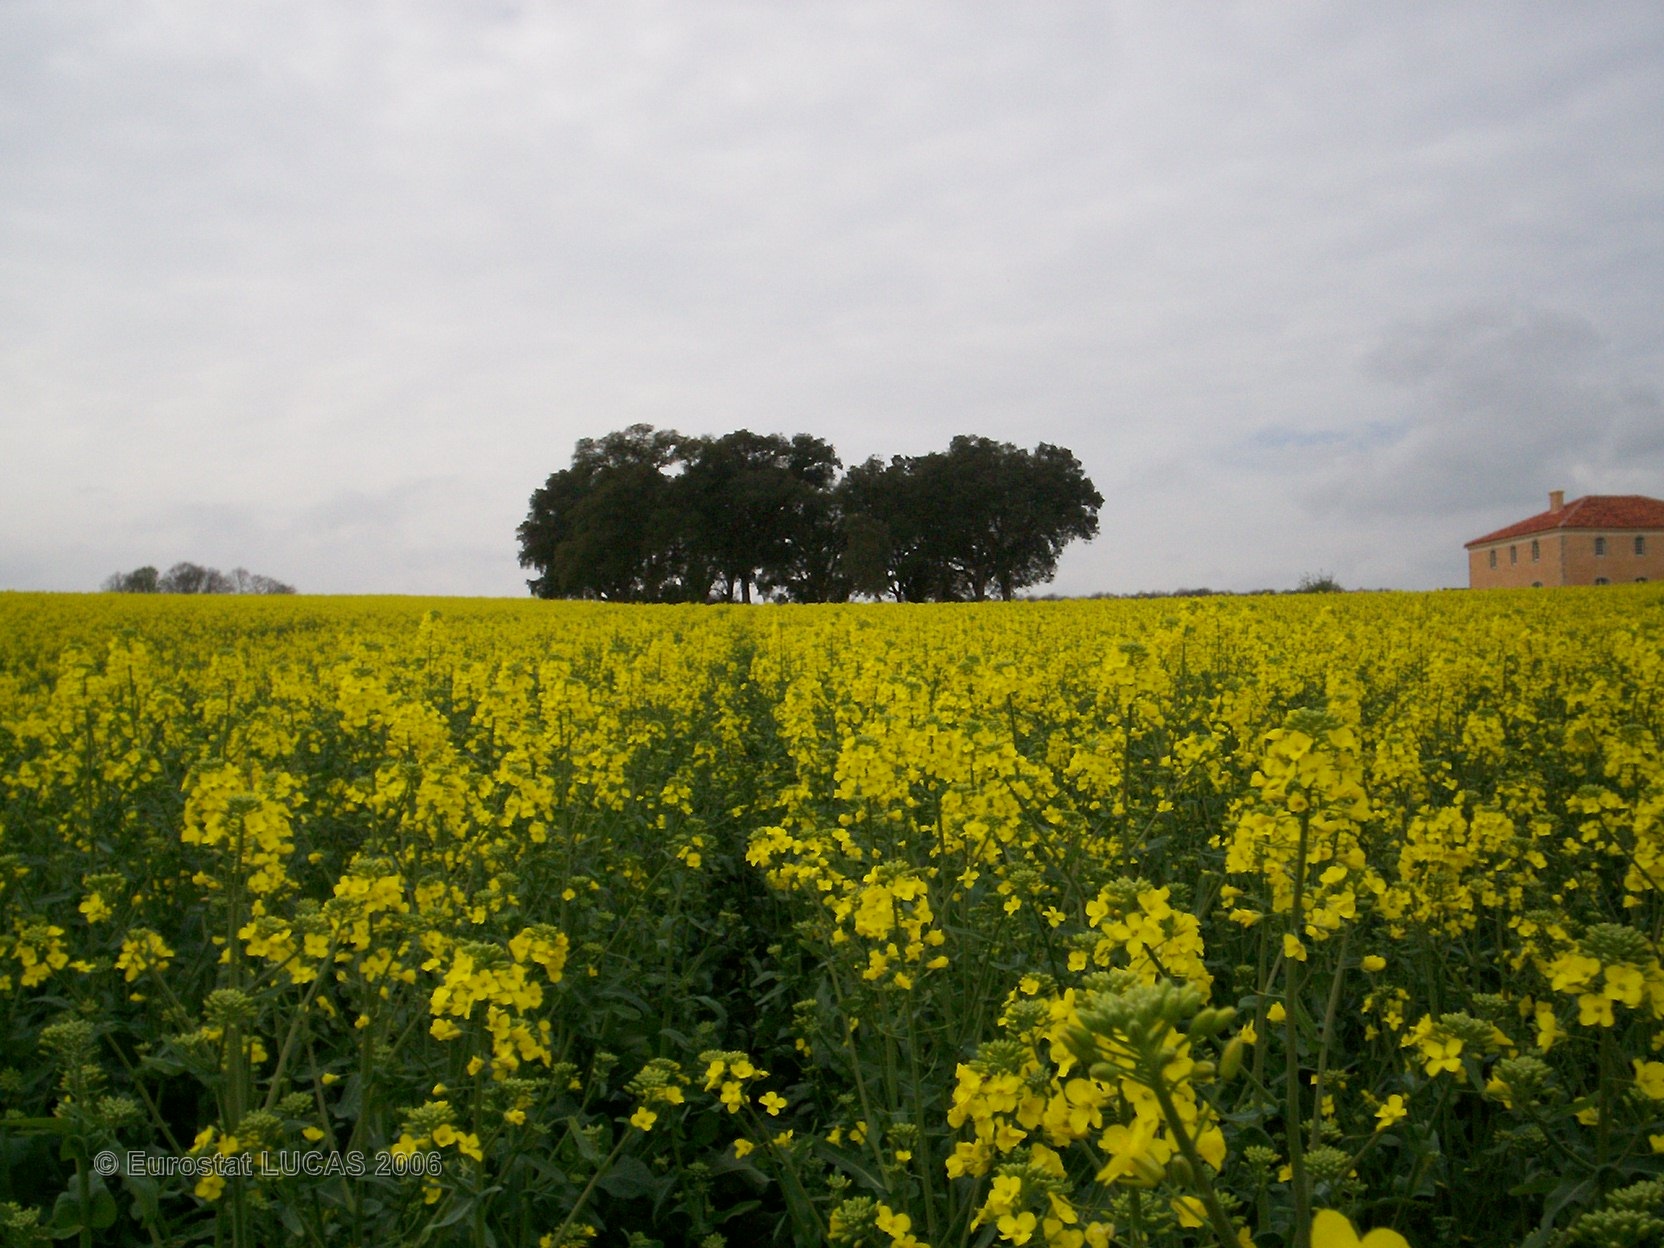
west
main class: Cropland
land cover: Rape and turnip rape
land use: Agriculture (excluding fallow land and kitchen gardens)
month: April
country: FR
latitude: 43.4969
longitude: 0.3136
